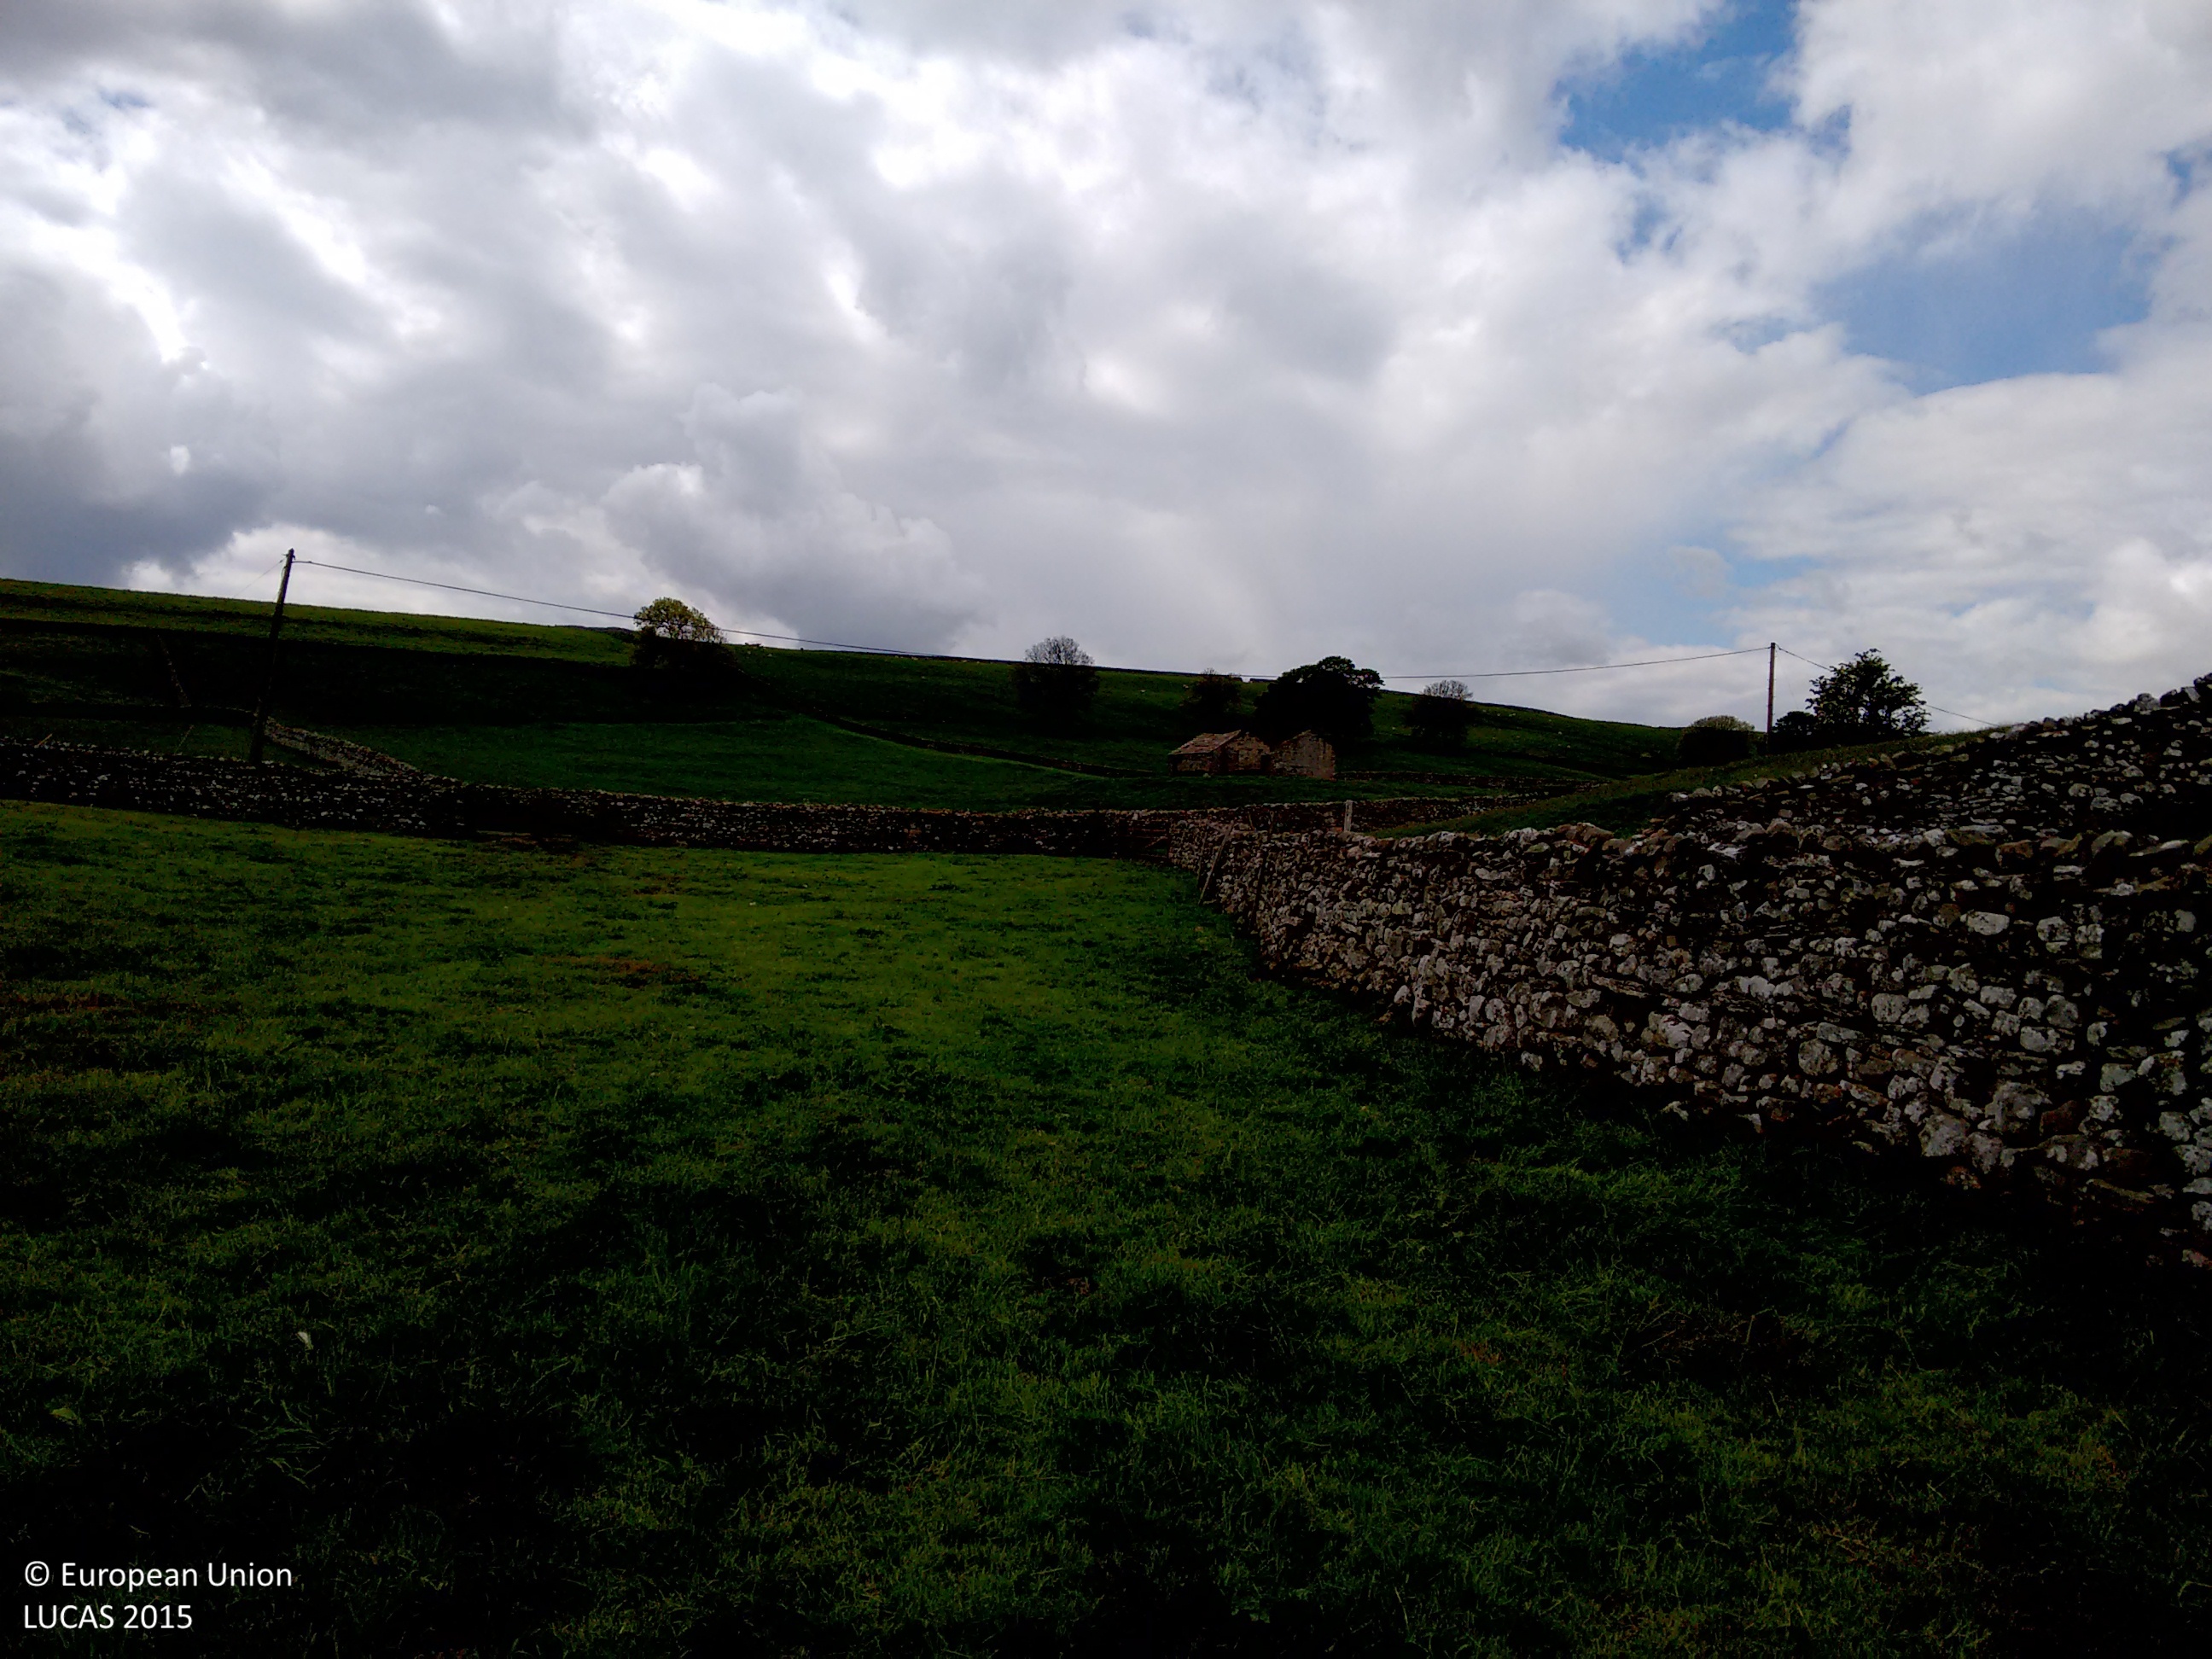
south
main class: Grassland
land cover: Grassland without tree/shrub cover
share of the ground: > 75 %
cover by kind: herbaceous plants 100 %
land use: Agriculture (excluding fallow land and kitchen gardens)
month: June
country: GB
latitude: 54.2916
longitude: -2.0246
